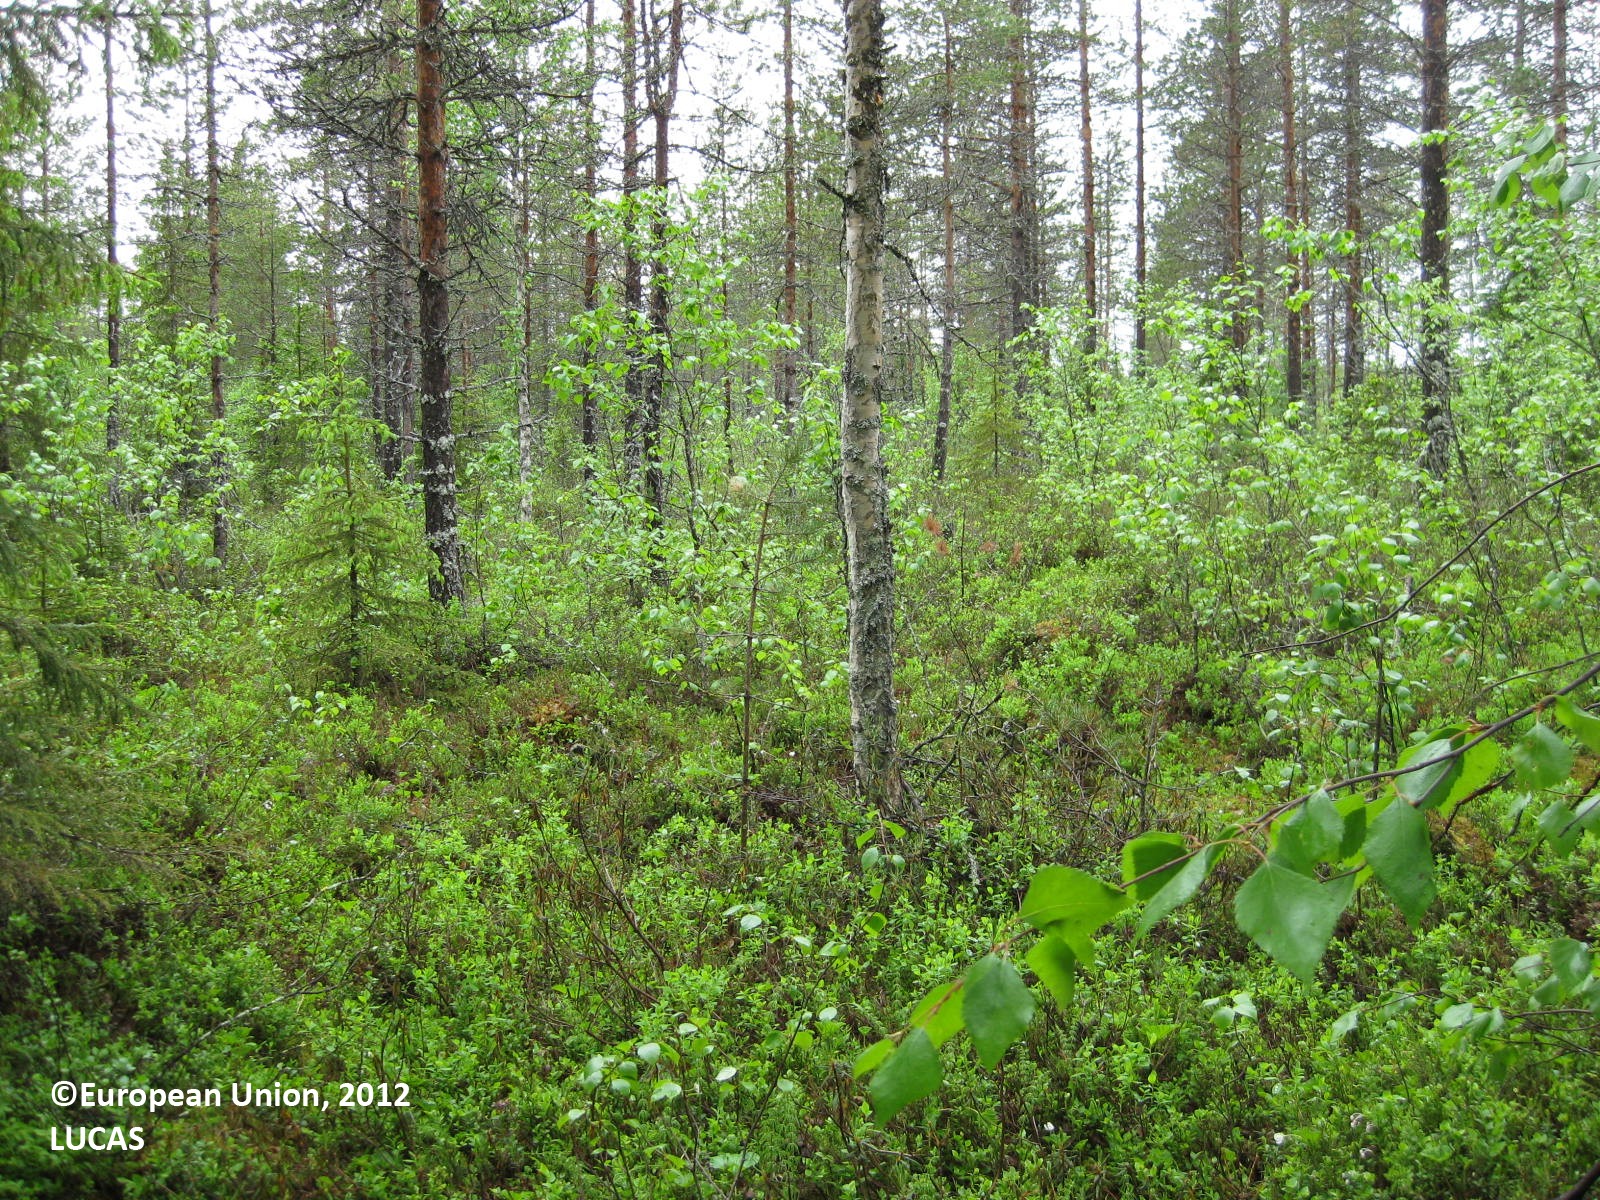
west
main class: Woodland
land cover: Other mixed woodland
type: boreal forest
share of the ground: > 75 %
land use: Forestry
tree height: > 5 m
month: June
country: FI
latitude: 65.0837
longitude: 29.0129
